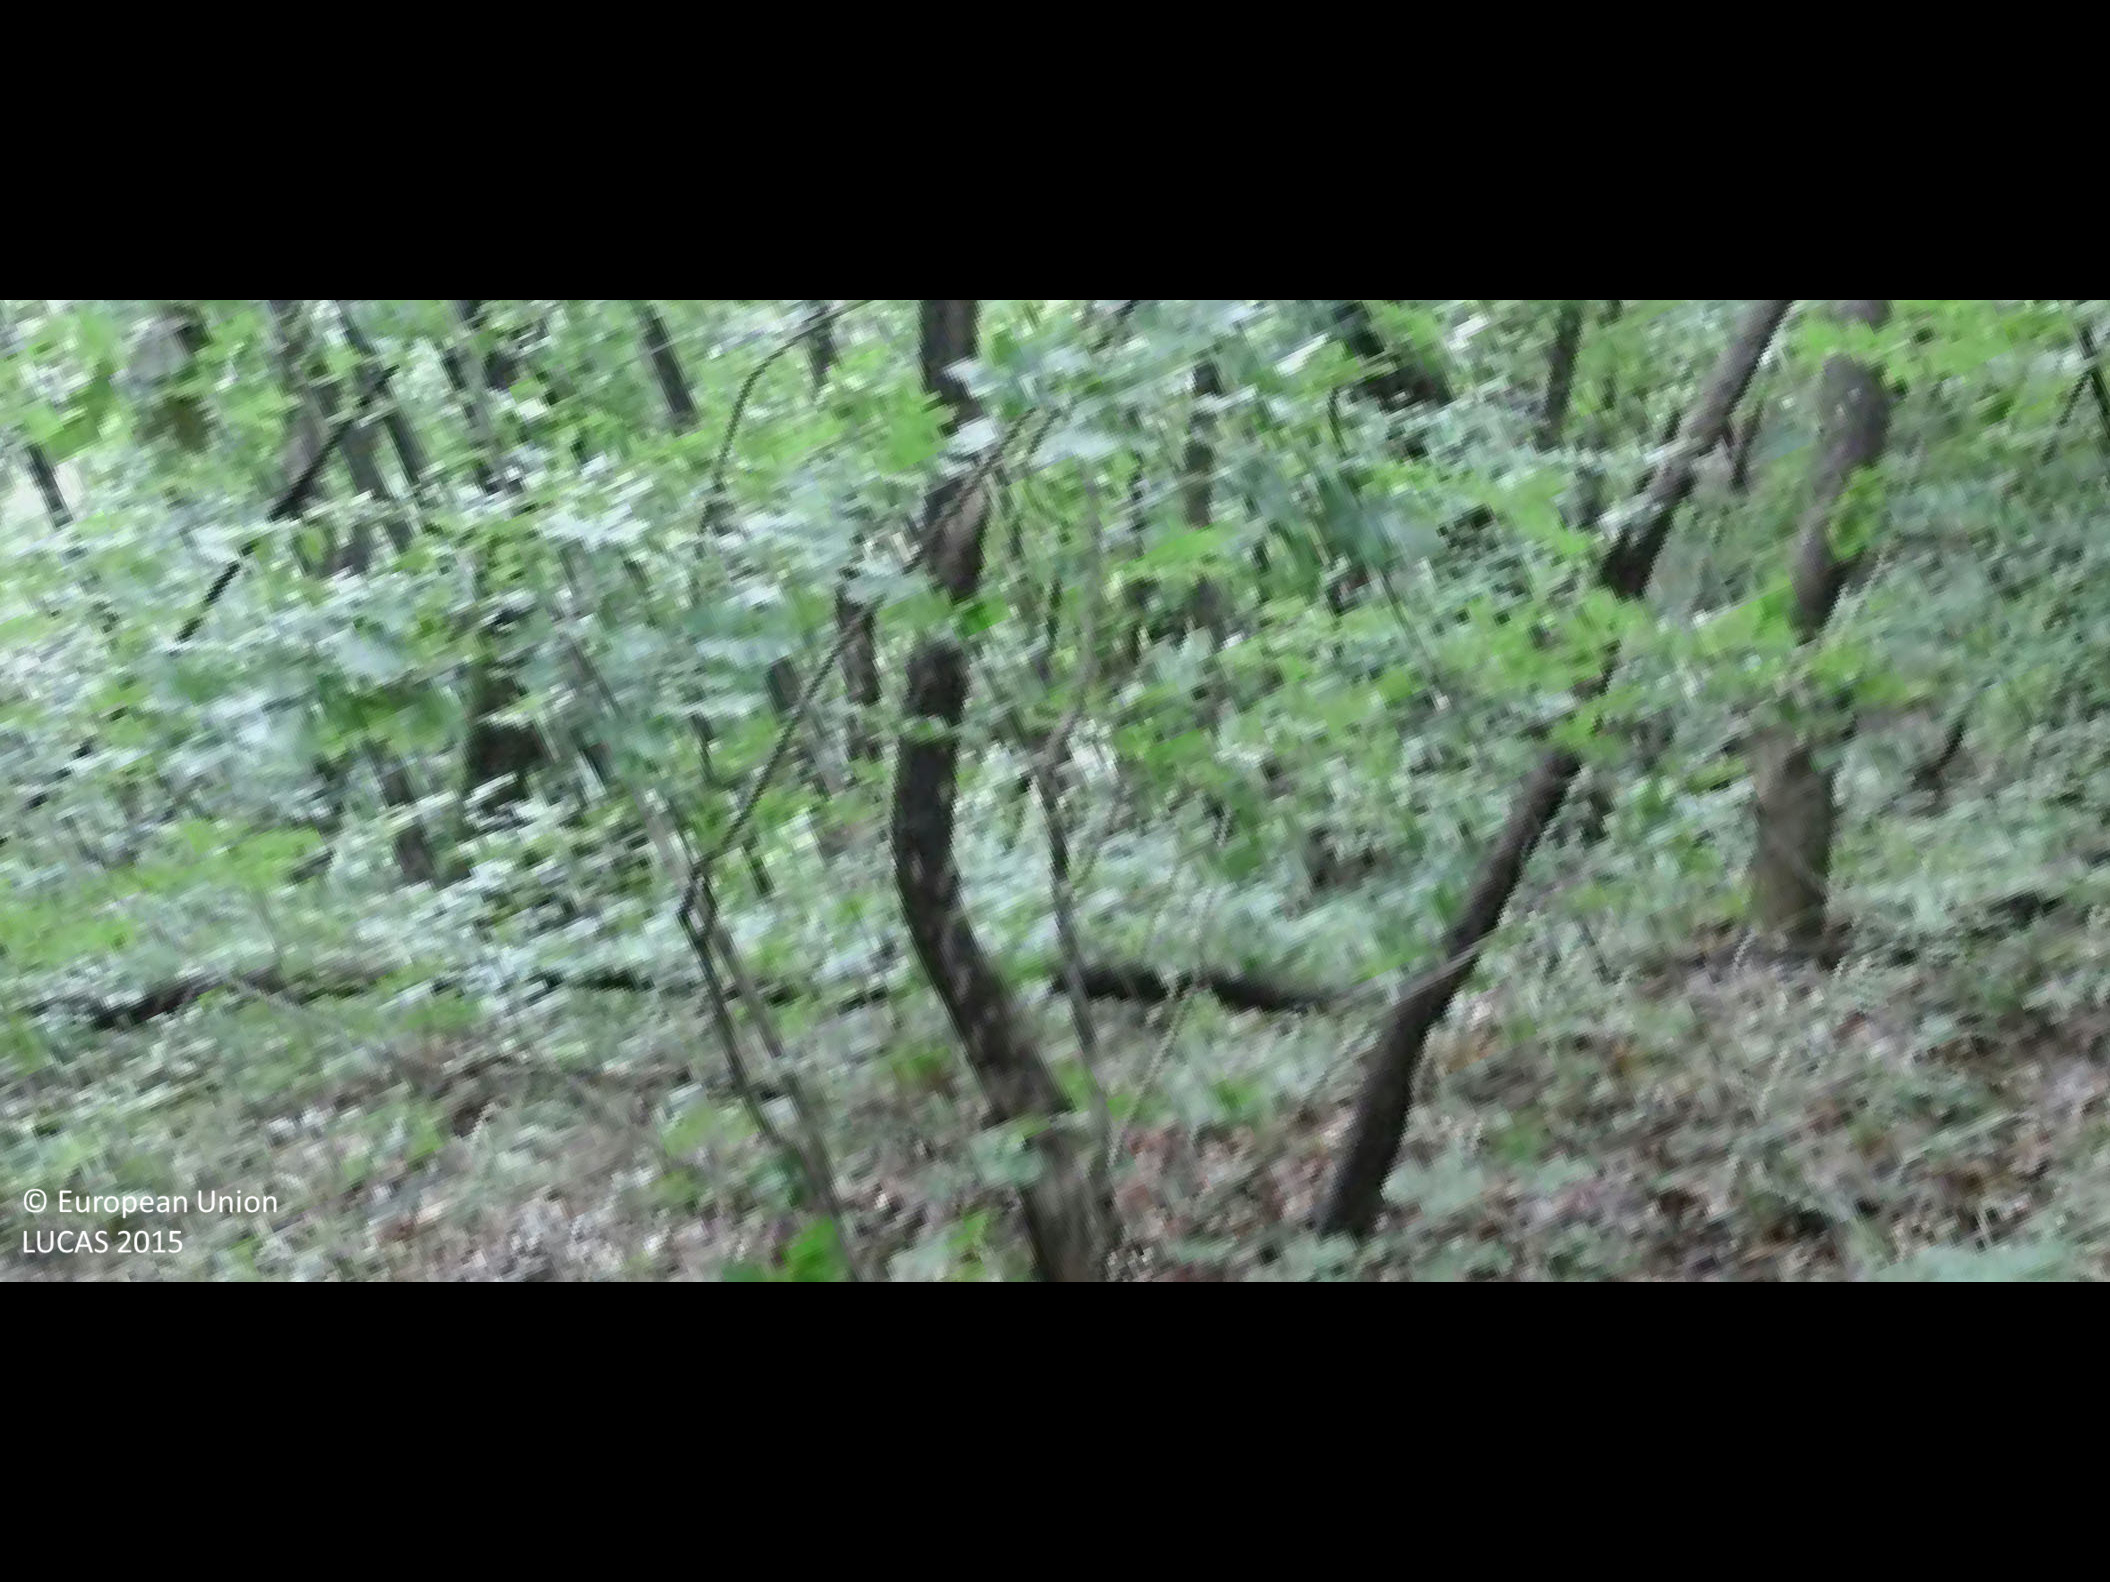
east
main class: Woodland
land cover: Broadleaved woodland
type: beech forest
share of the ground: > 75 %
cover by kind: broadleaved forest trees 90 %, herbaceous plants 10 %
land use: Forestry
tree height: > 5 m
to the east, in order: Broadleaved woodland; Paved roads, cycling and walking lanes; Ditches and canals; Broadleaved woodland; Fences; Grassland with sparse tree/shrub cover
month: July
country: HU
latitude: 46.1799
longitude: 17.9732
